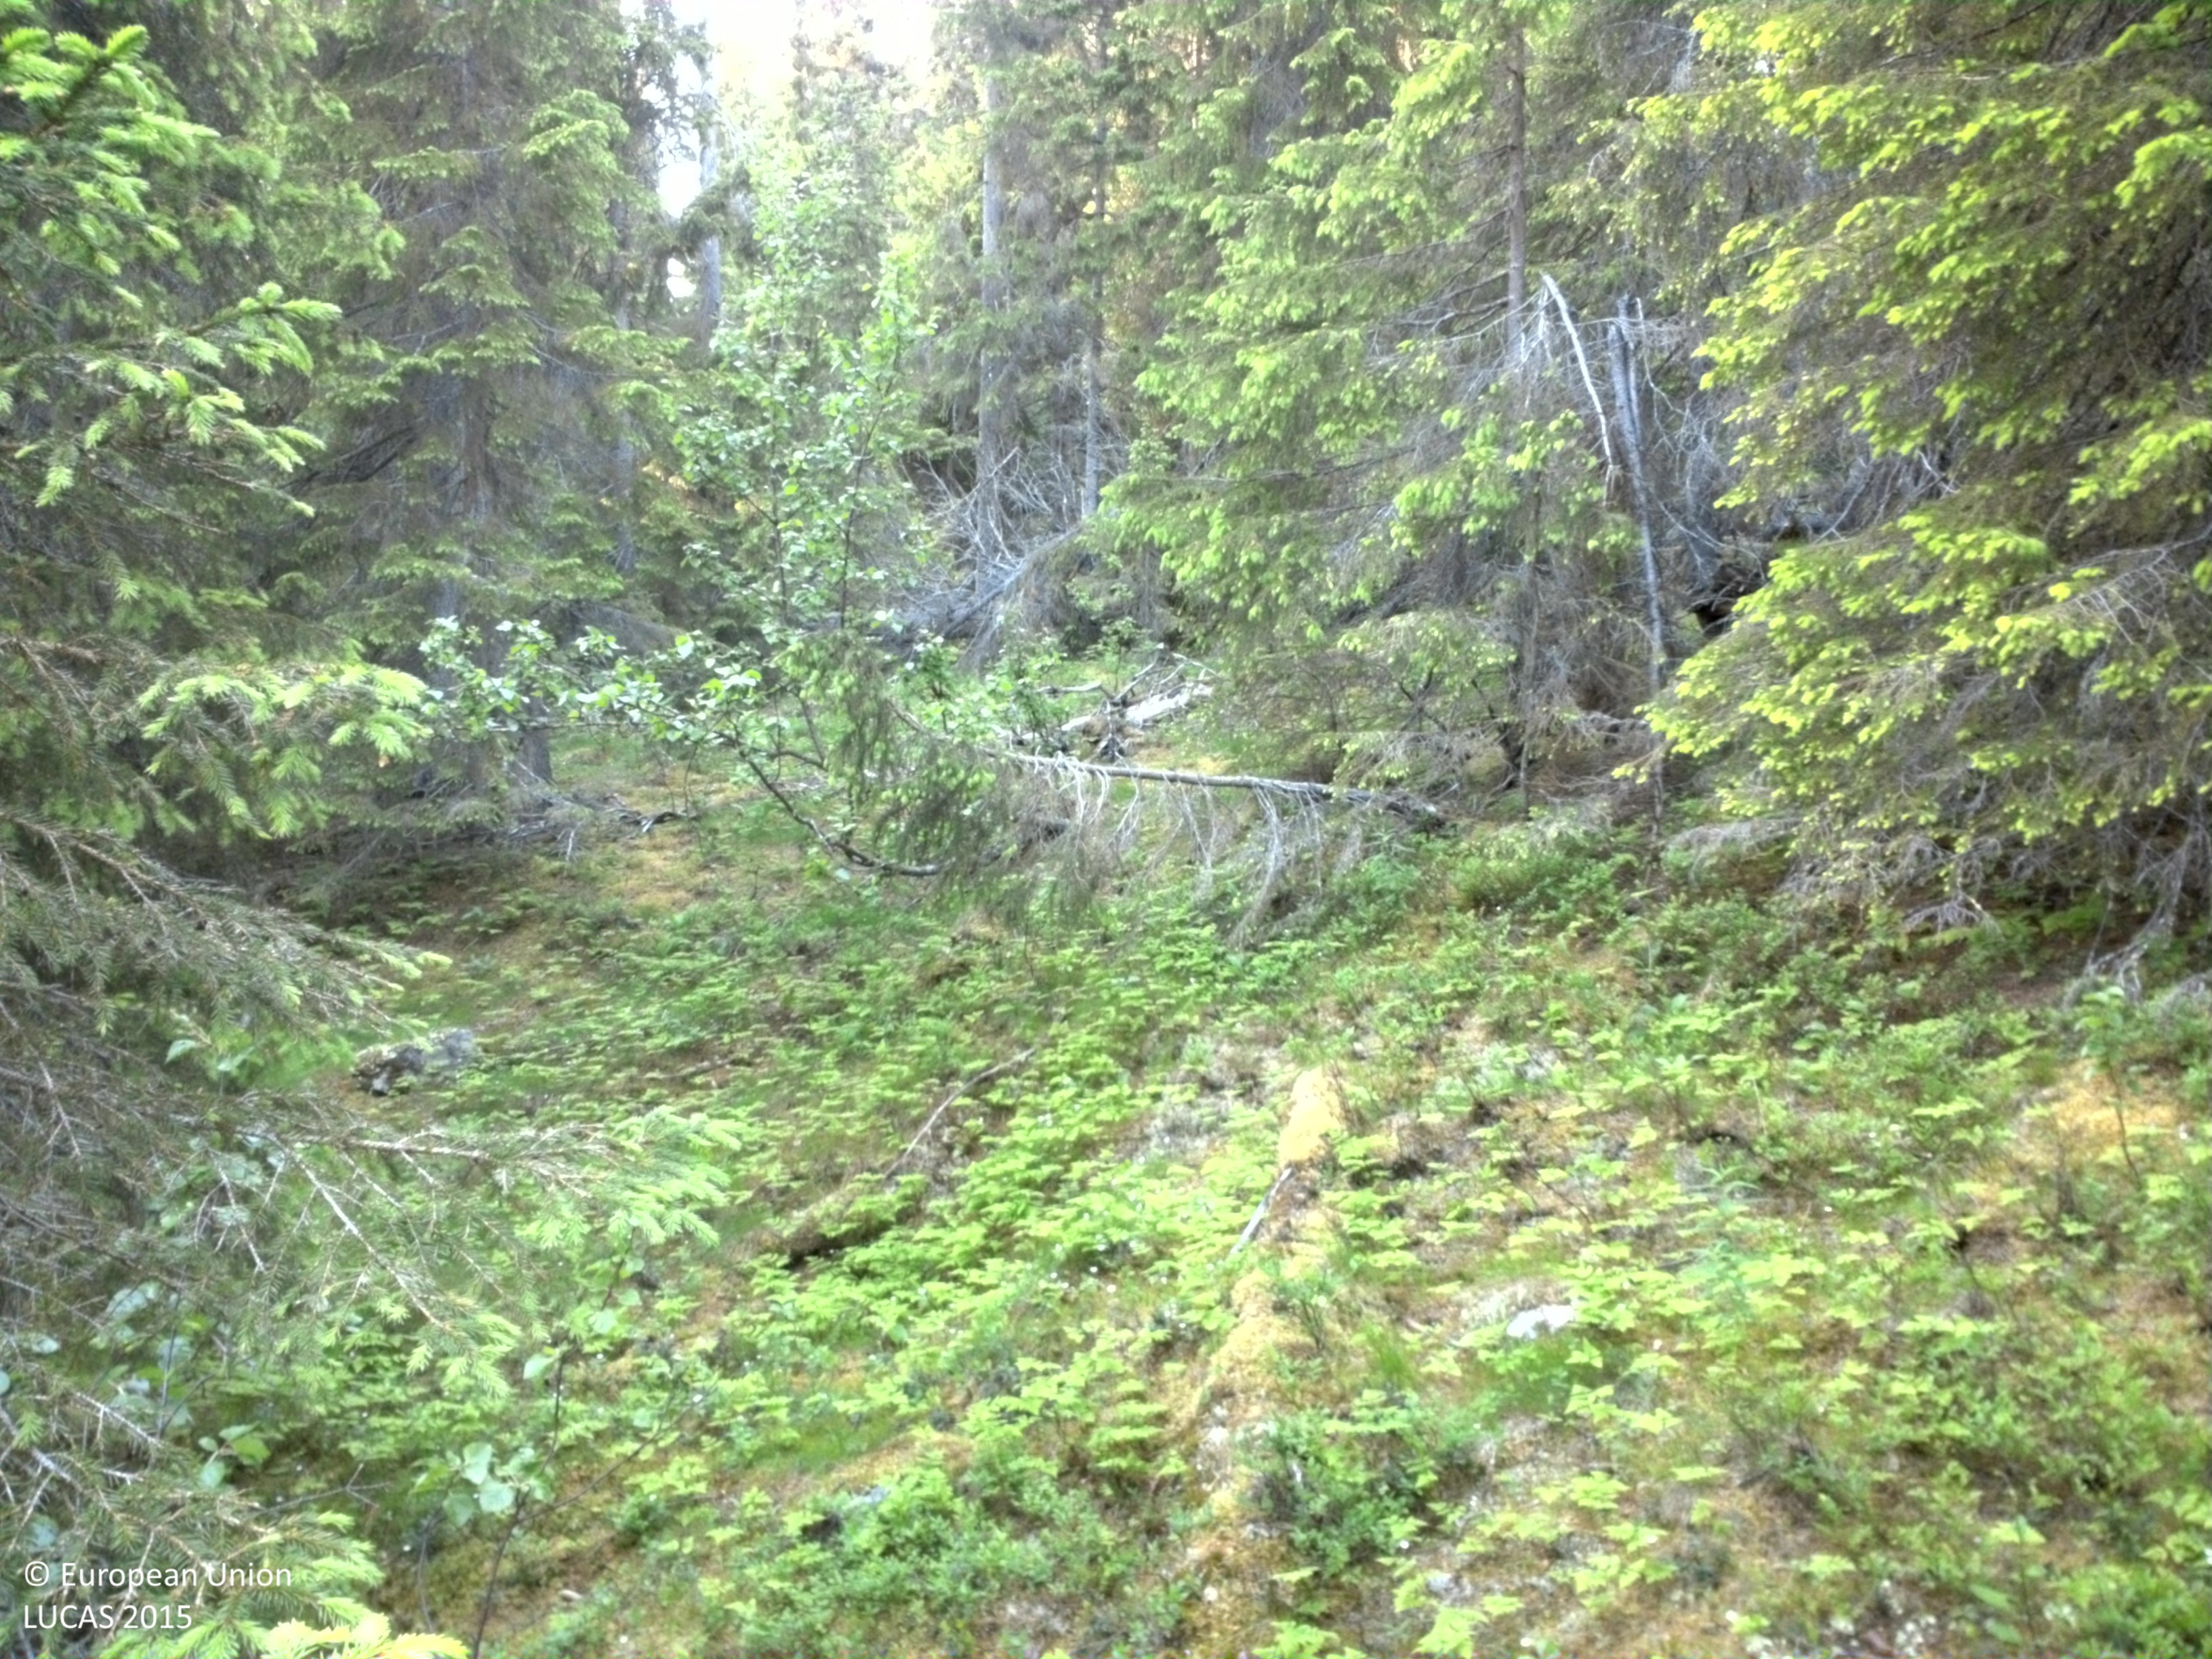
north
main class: Woodland
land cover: Spruce dominated coniferous woodland
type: boreal forest
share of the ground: 25 - 50 %
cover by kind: coniferous forest trees 40 %, herbaceous plants 35 %, lichens and mosses 15 %, shrubs 10 %
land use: Forestry
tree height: > 5 m
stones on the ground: 10 - 25 %
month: July
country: SE
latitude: 65.7013
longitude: 15.3870
